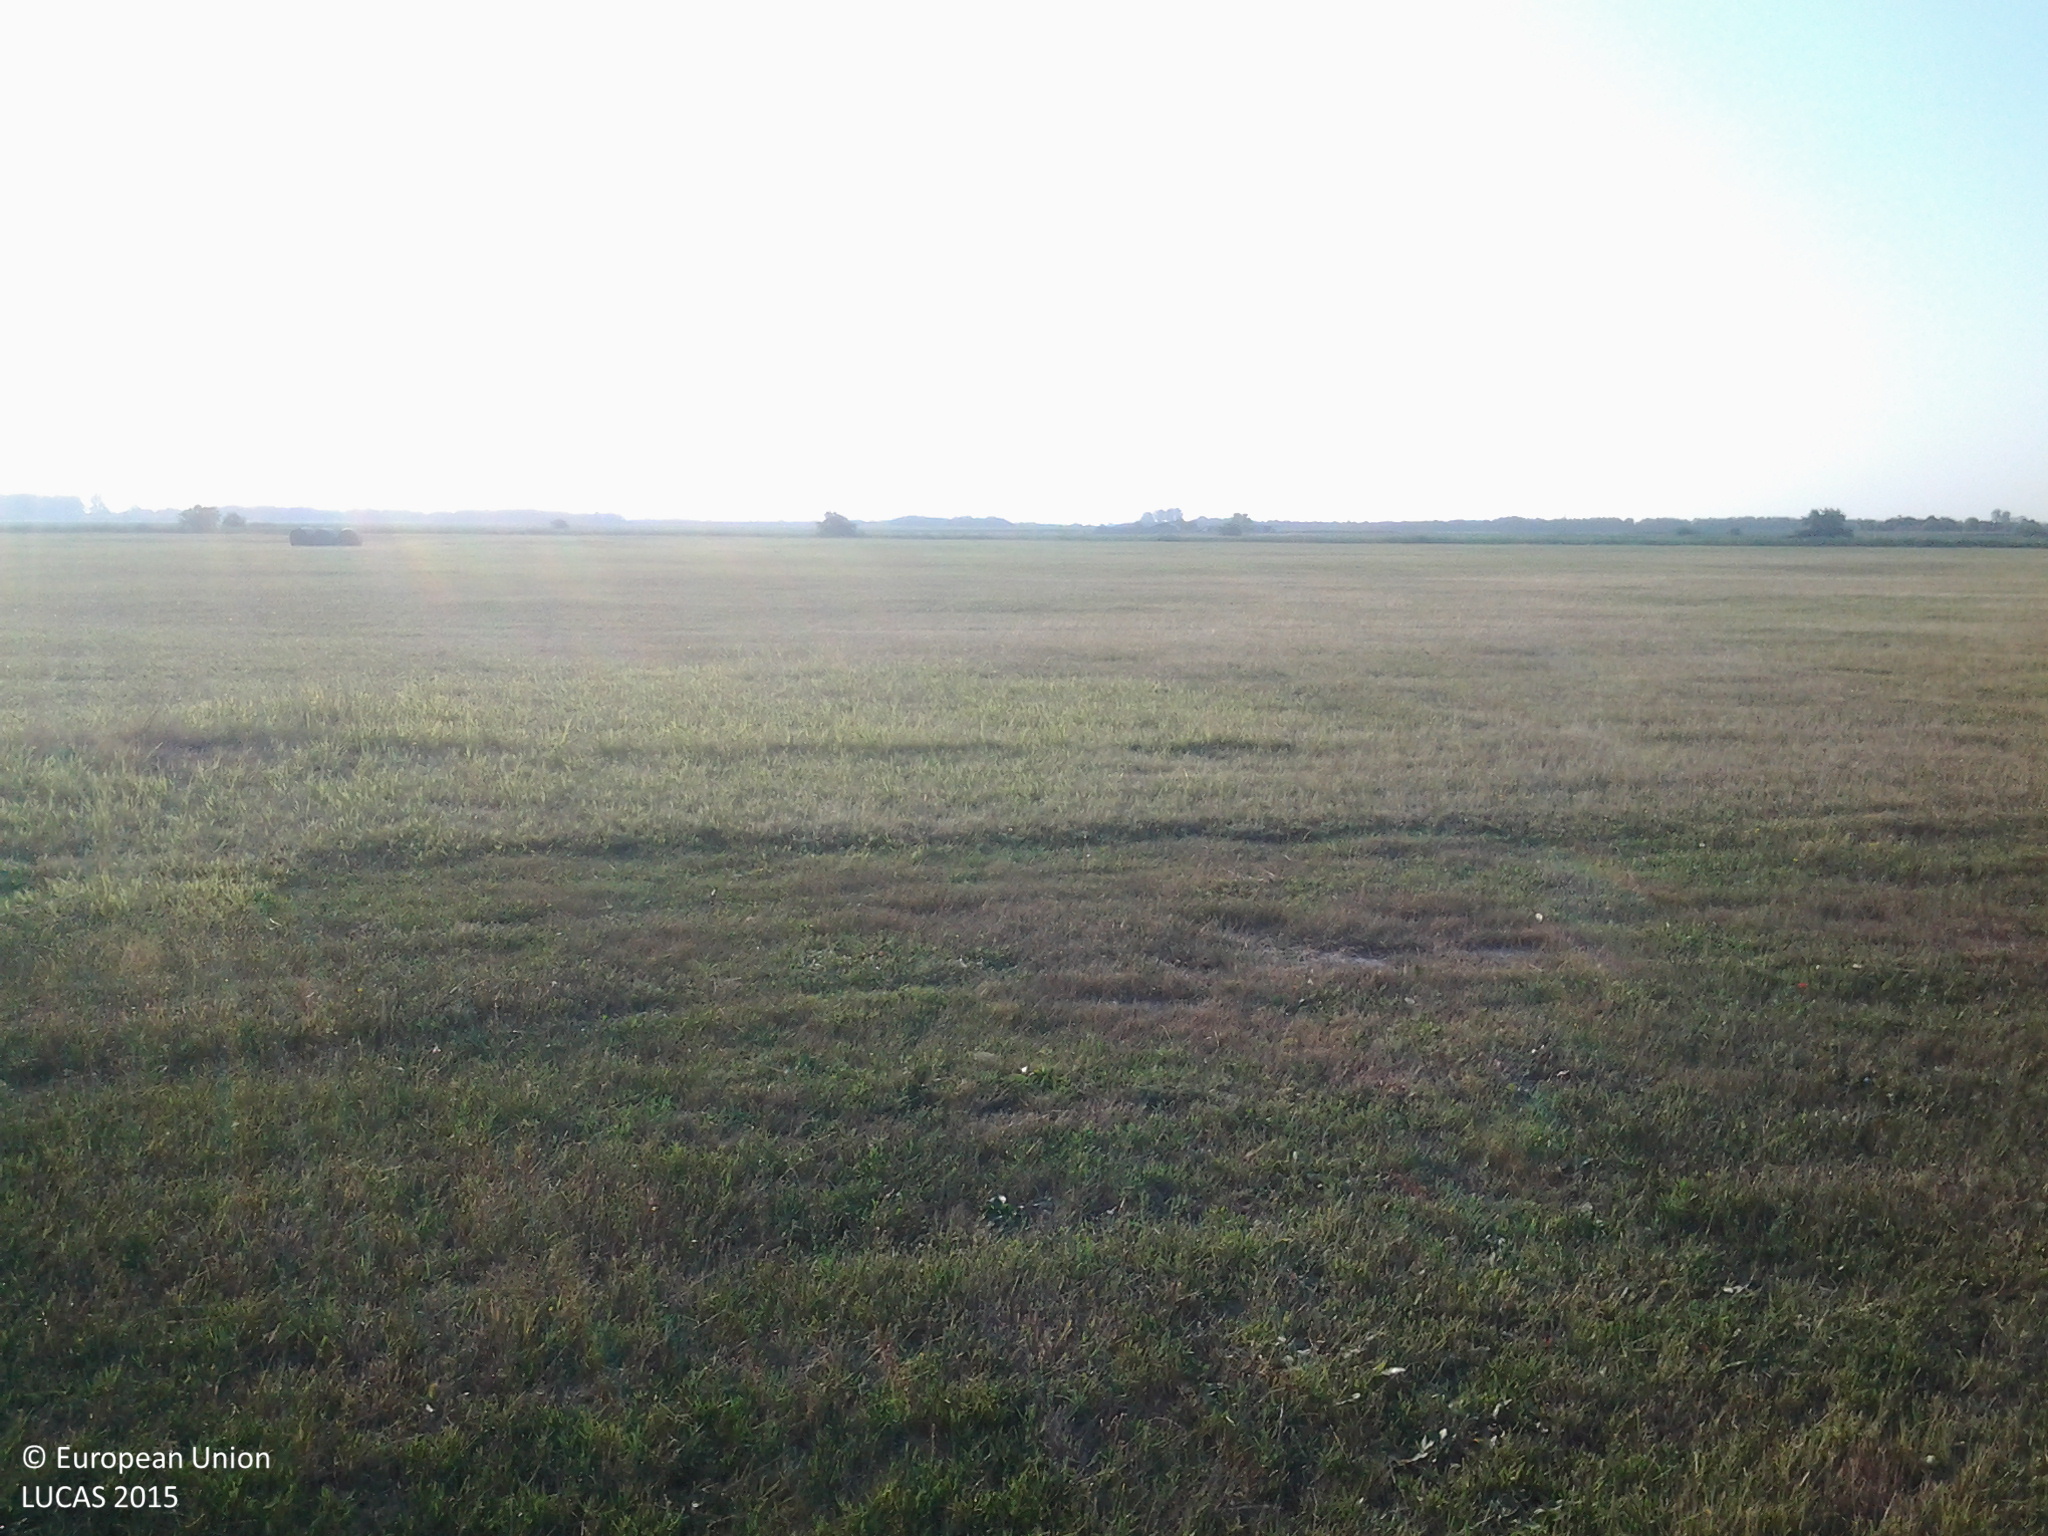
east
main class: Grassland
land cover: Grassland without tree/shrub cover
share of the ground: 50 - 75 %
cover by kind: herbaceous plants 100 %
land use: Agriculture (excluding fallow land and kitchen gardens)
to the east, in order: Grassland without tree/shrub cover
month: July
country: HU
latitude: 46.8858
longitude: 19.1104
